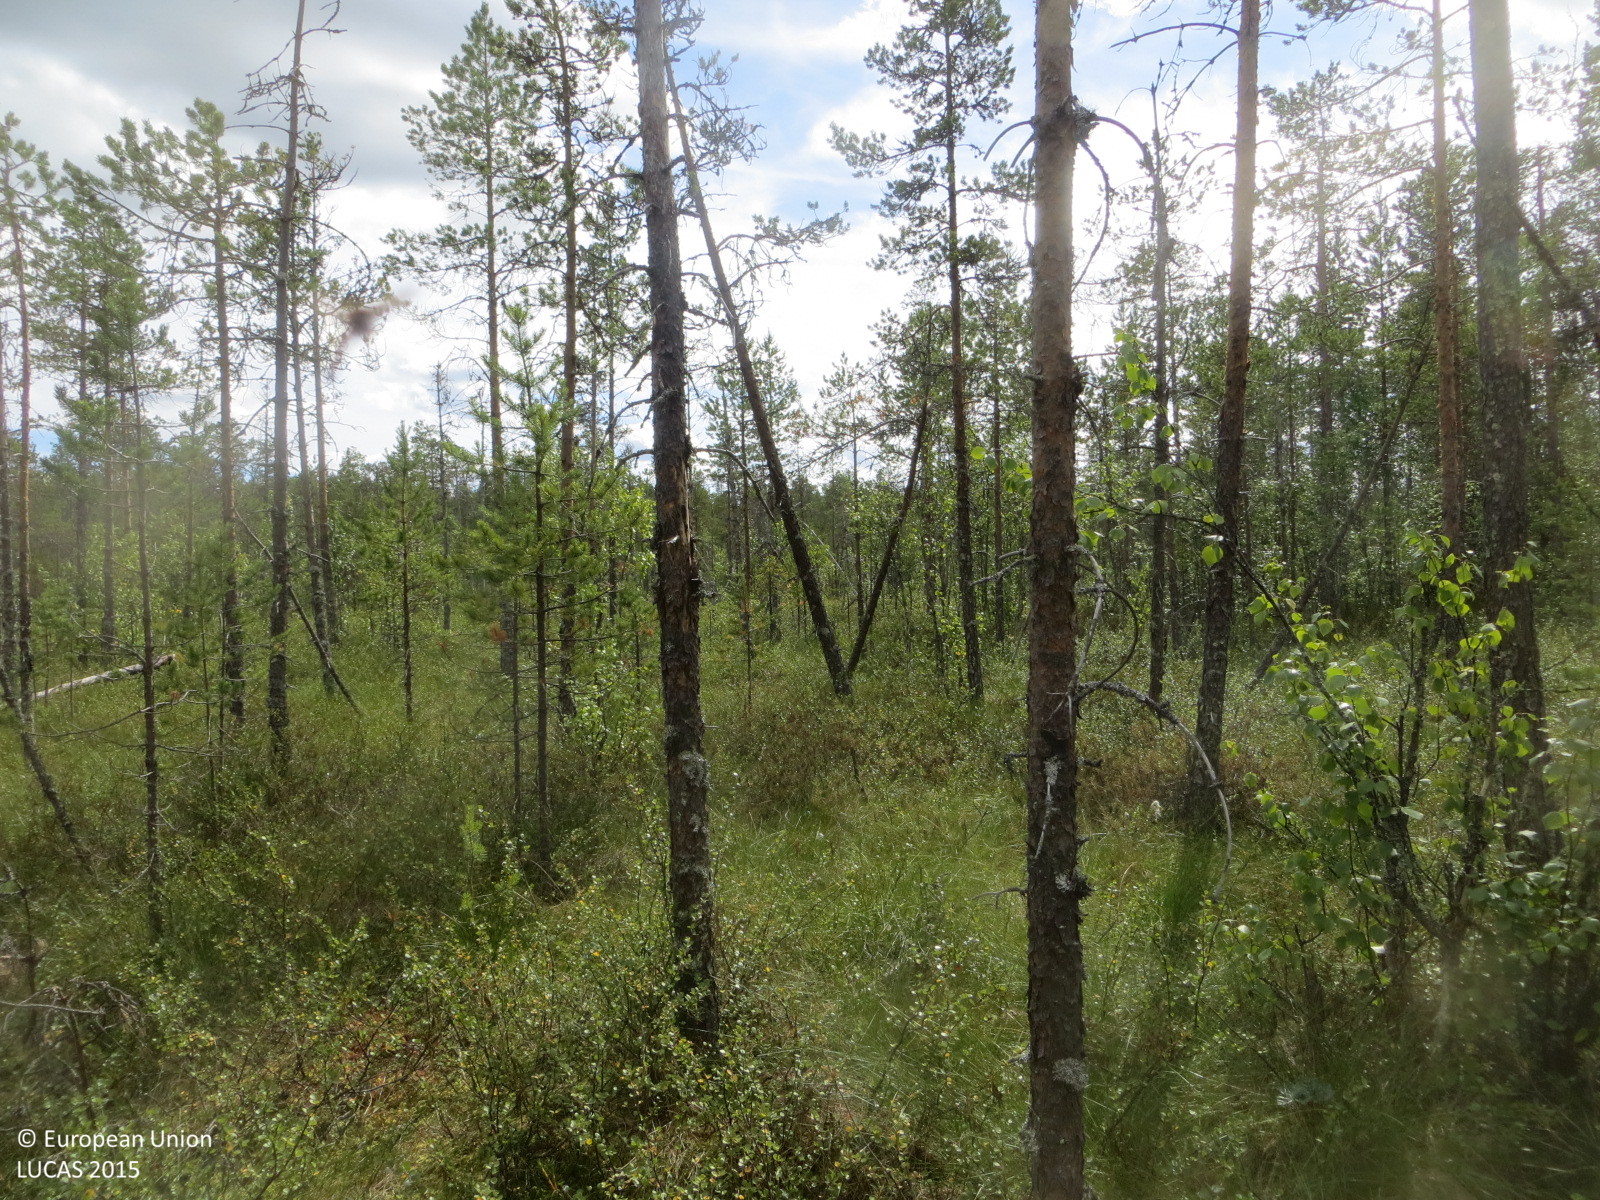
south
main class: Woodland
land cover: Pine dominated coniferous woodland
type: mire and swamp forests
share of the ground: 50 - 75 %
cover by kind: coniferous forest trees 50 %, shrubs 45 %, broadleaved forest trees 5 %
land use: Forestry
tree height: > 5 m
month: August
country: FI
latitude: 66.1886
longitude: 25.4499
